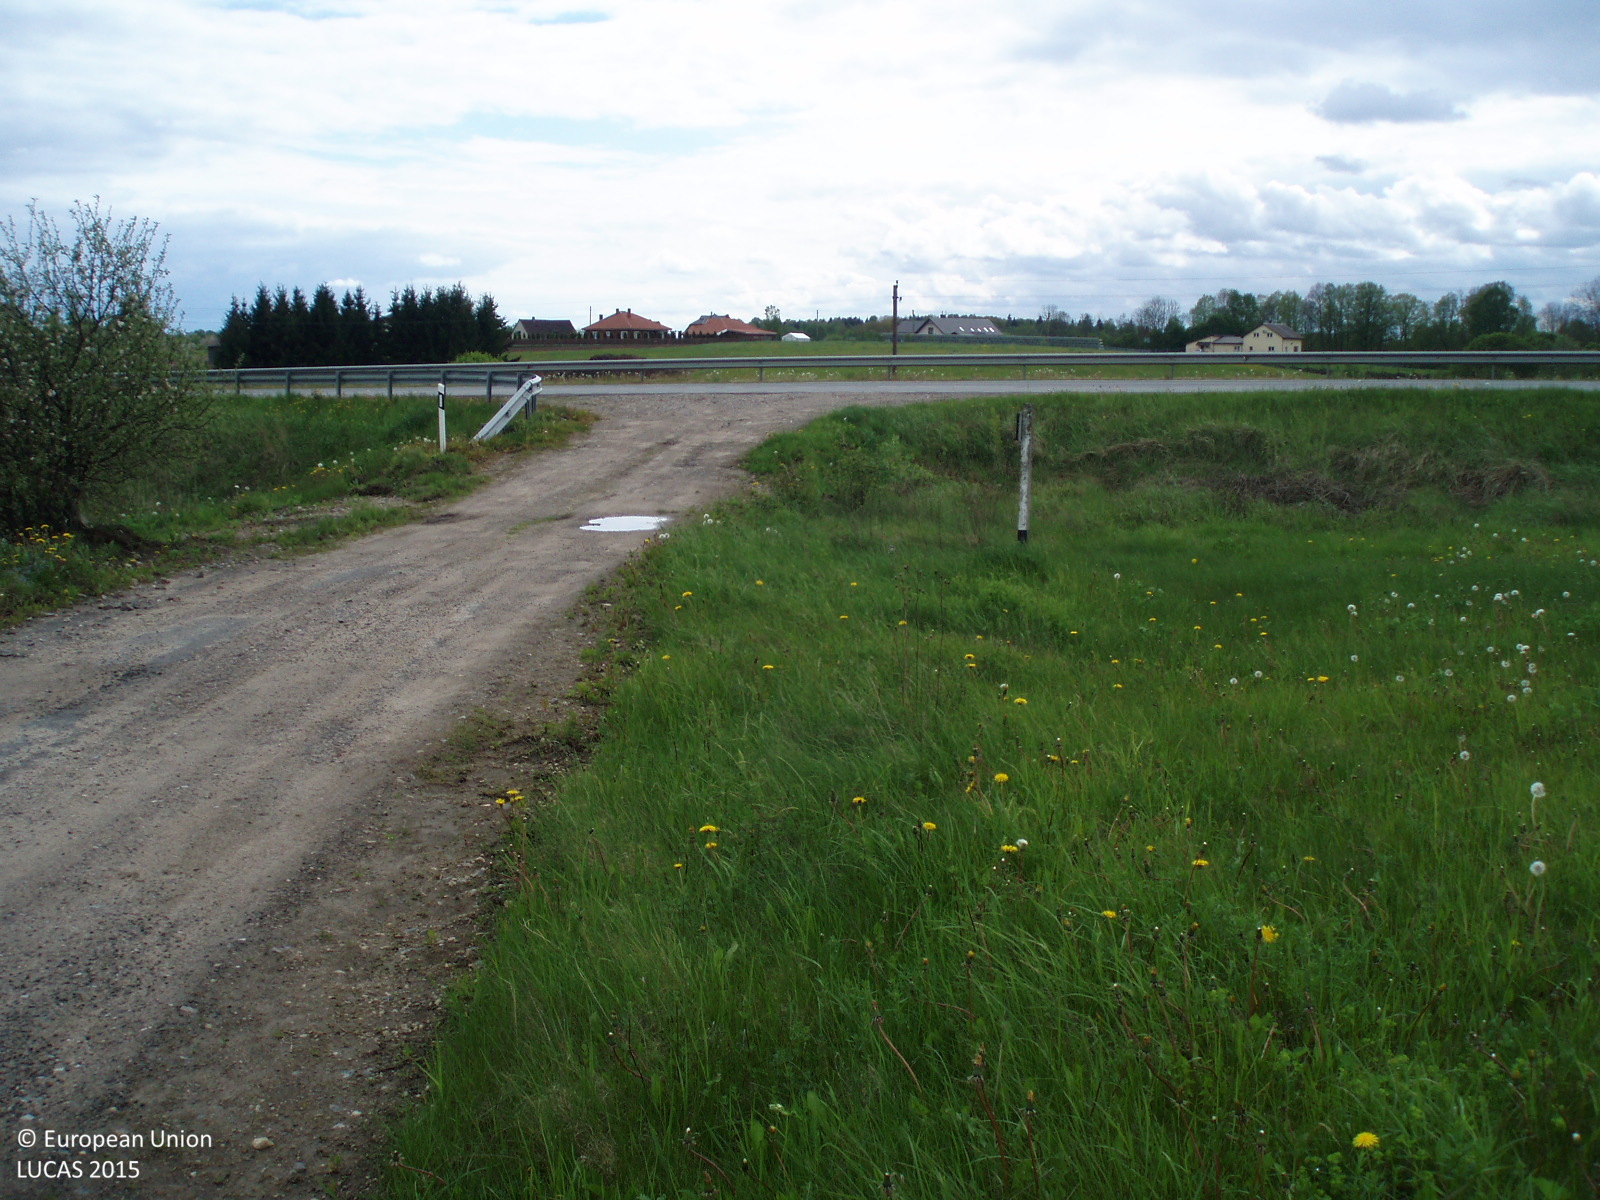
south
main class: Grassland
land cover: Grassland without tree/shrub cover
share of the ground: > 75 %
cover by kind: herbaceous plants 100 %
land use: Agriculture (excluding fallow land and kitchen gardens)
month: May
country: LT
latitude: 56.2746
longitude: 22.4111
